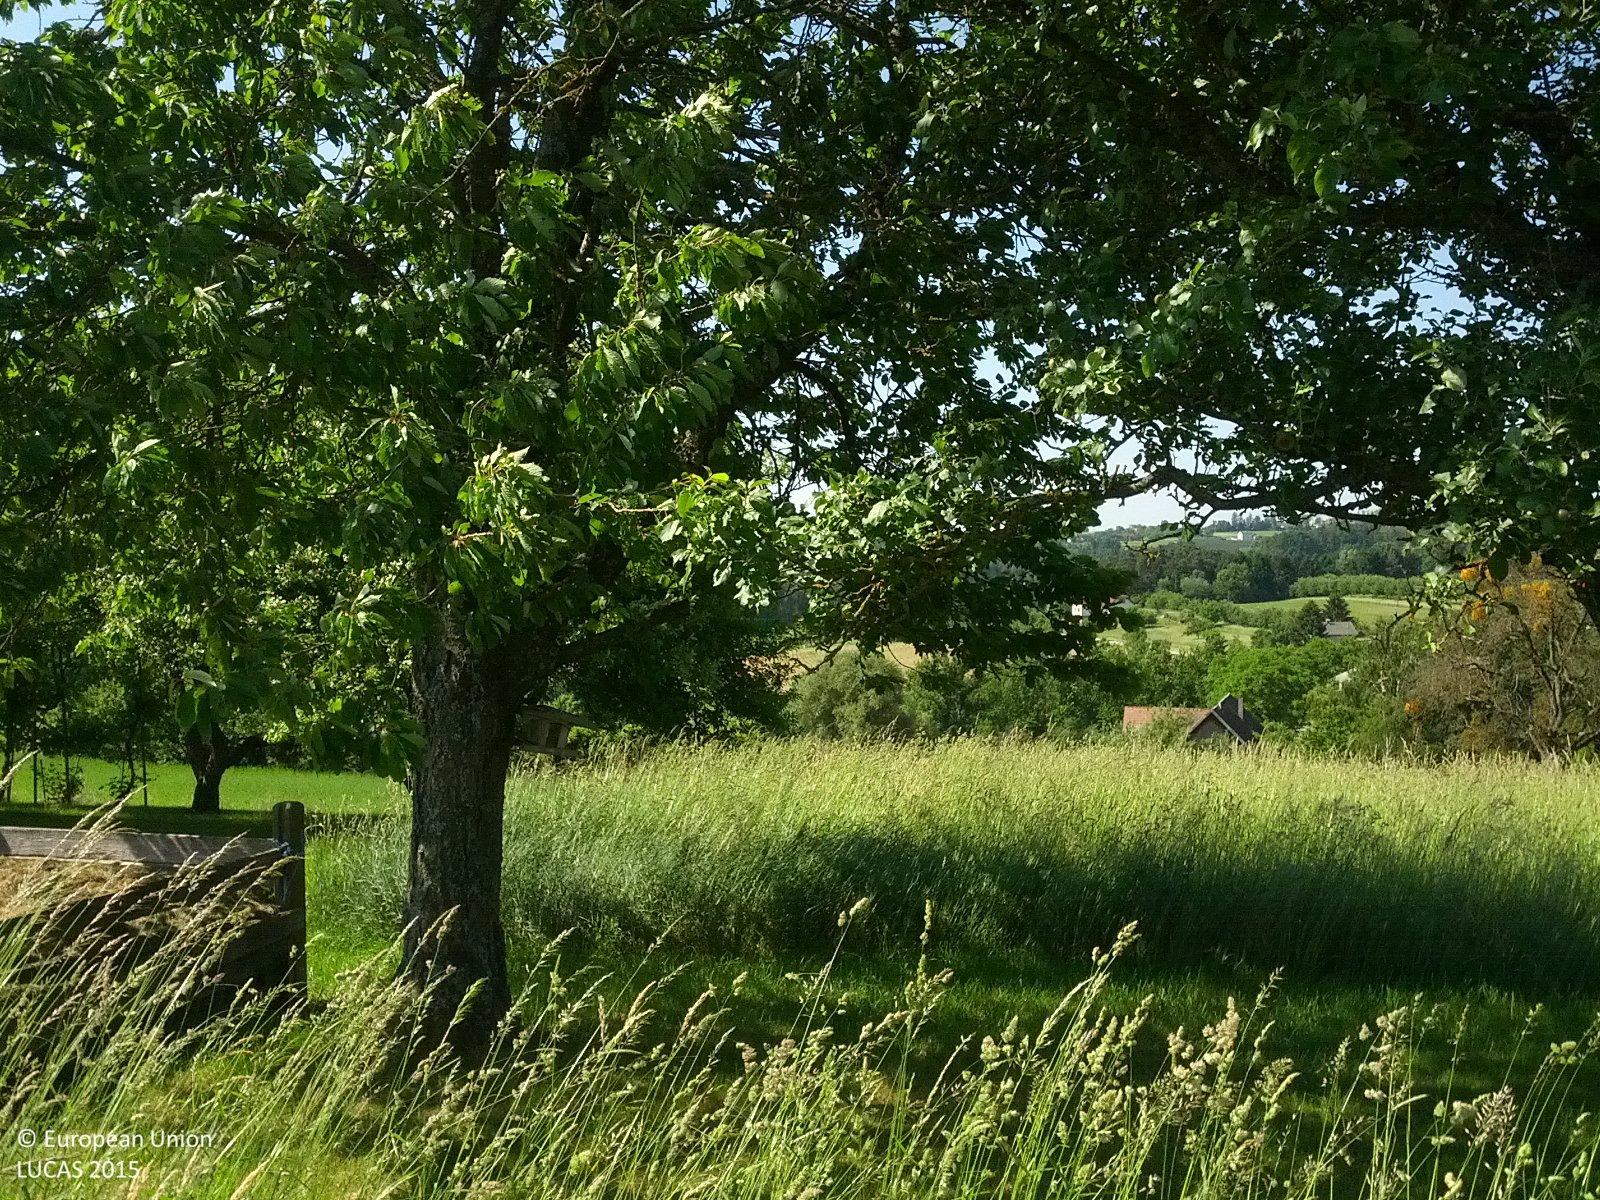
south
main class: Grassland
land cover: Grassland without tree/shrub cover
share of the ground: > 75 %
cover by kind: herbaceous plants 100 %
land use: Agriculture (excluding fallow land and kitchen gardens)
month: June
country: AT
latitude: 47.1861
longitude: 16.1384
